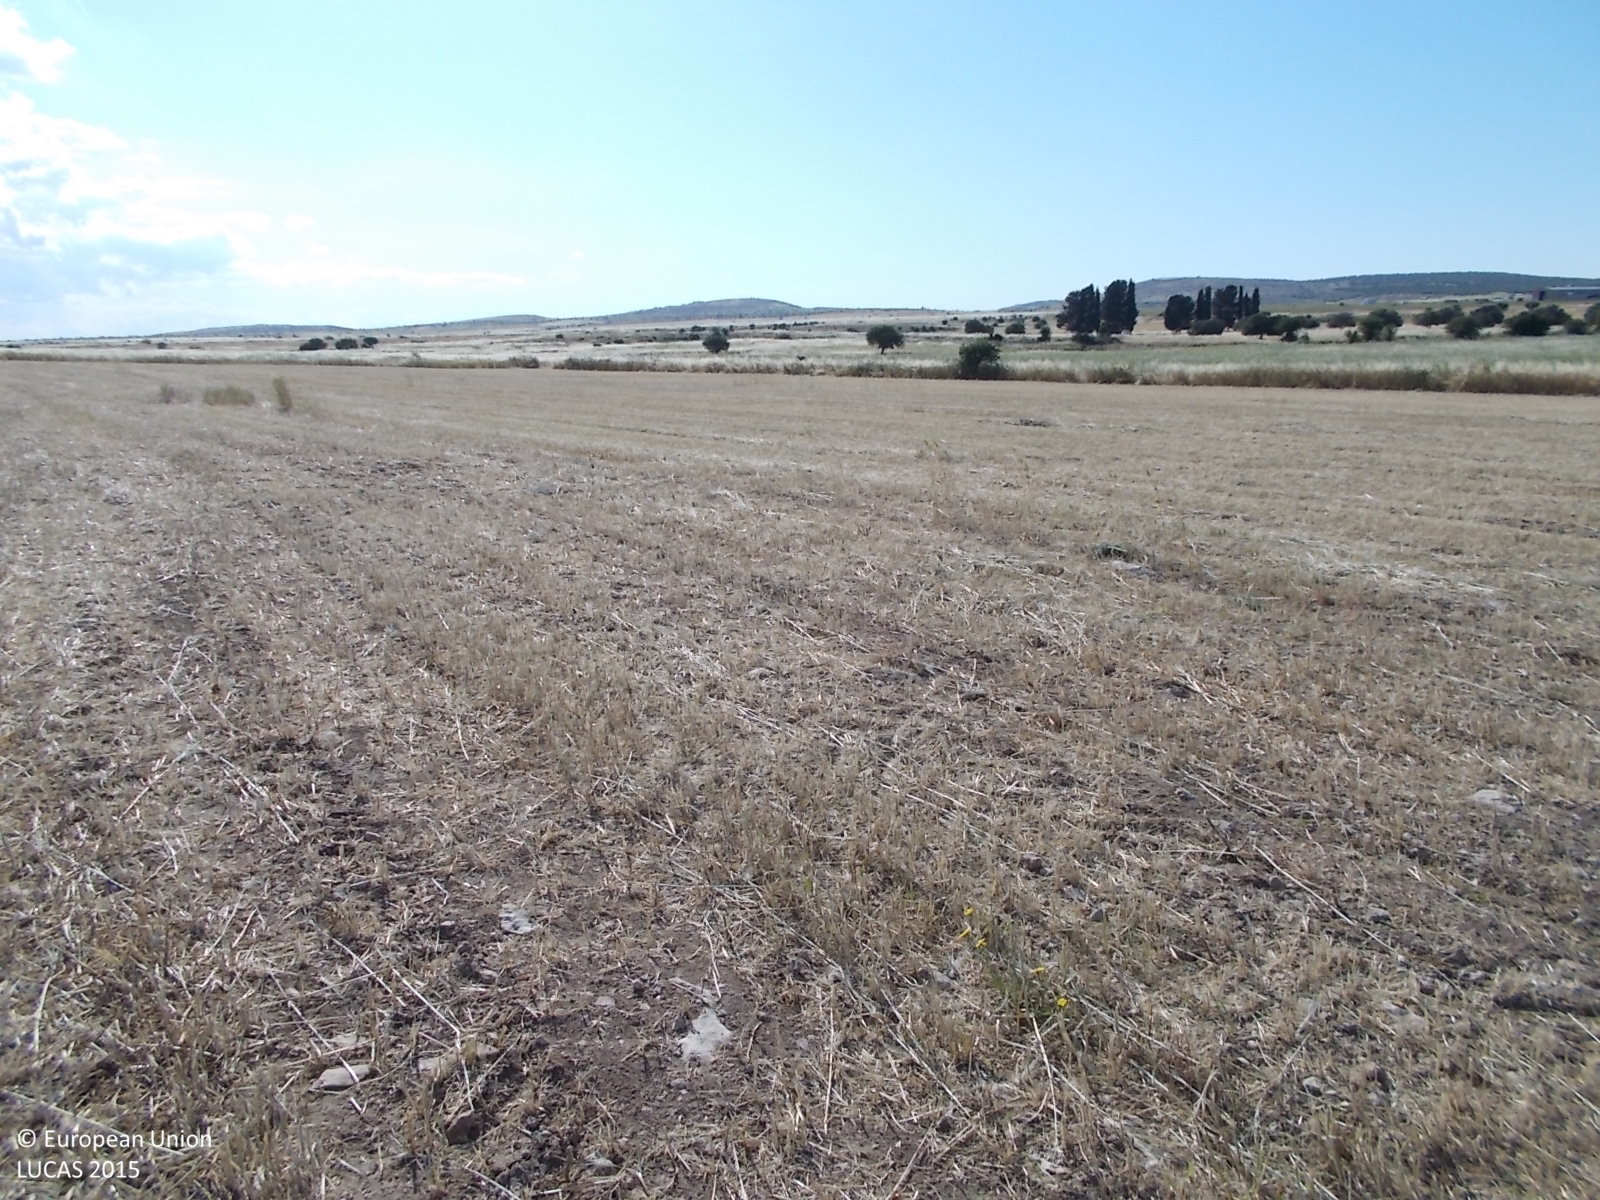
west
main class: Cropland
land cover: Common wheat
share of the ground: < 10 %
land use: Agriculture (excluding fallow land and kitchen gardens)
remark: Harvested field
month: April
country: CY
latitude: 35.0276
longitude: 33.6911
